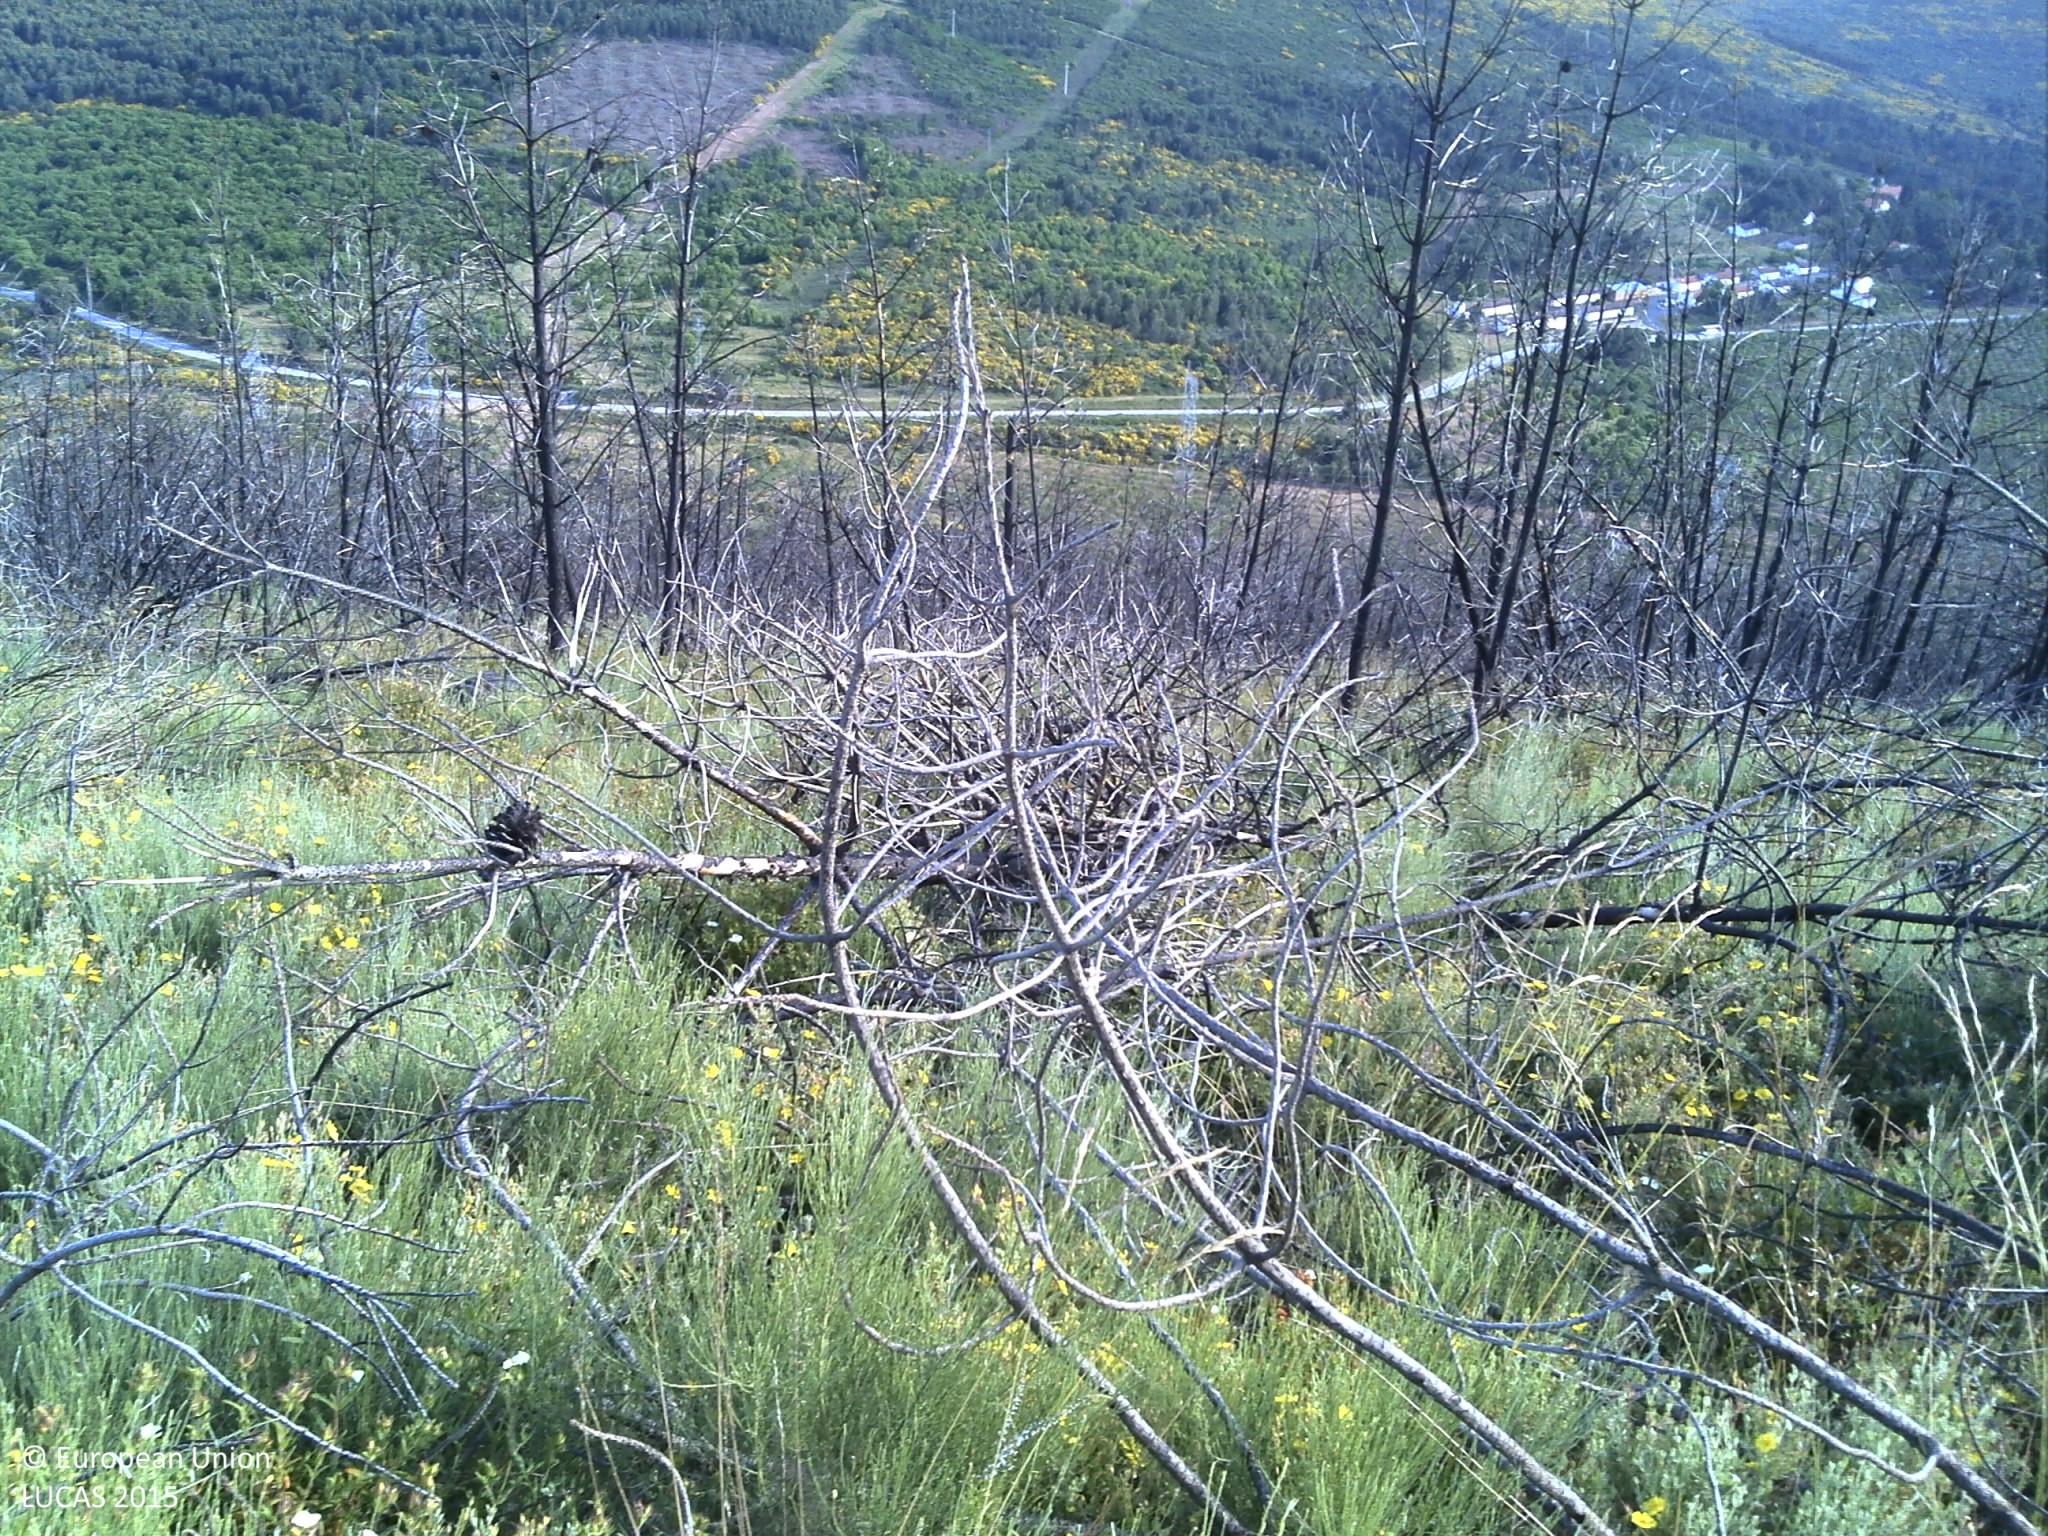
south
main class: Shrubland
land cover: Shrubland without tree cover
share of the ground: > 75 %
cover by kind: shrubs 90 %, herbaceous plants 10 %
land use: Forestry
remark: Burnt area
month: May
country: PT
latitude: 41.1936
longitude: -6.9566
